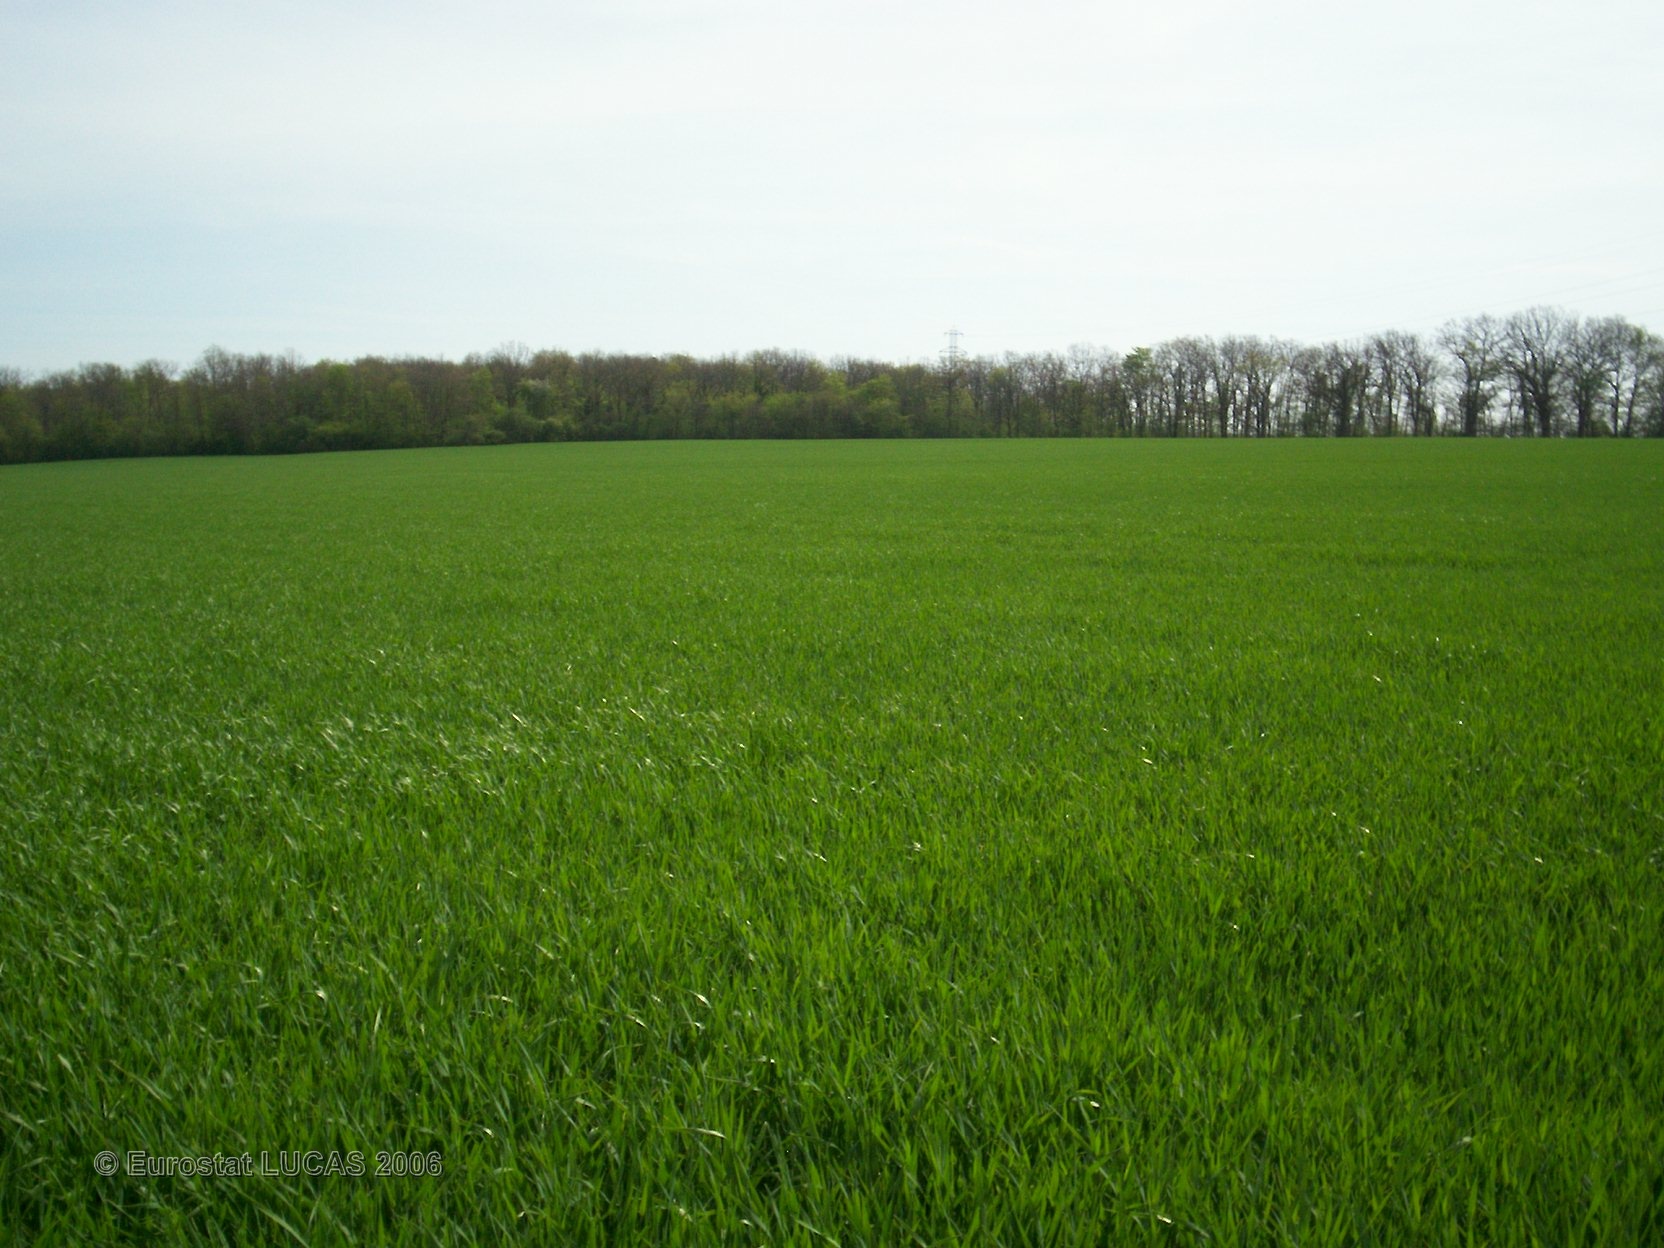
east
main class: Cropland
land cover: Barley
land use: Agriculture (excluding fallow land and kitchen gardens)
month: May
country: FR
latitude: 47.8521
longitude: 4.5055
